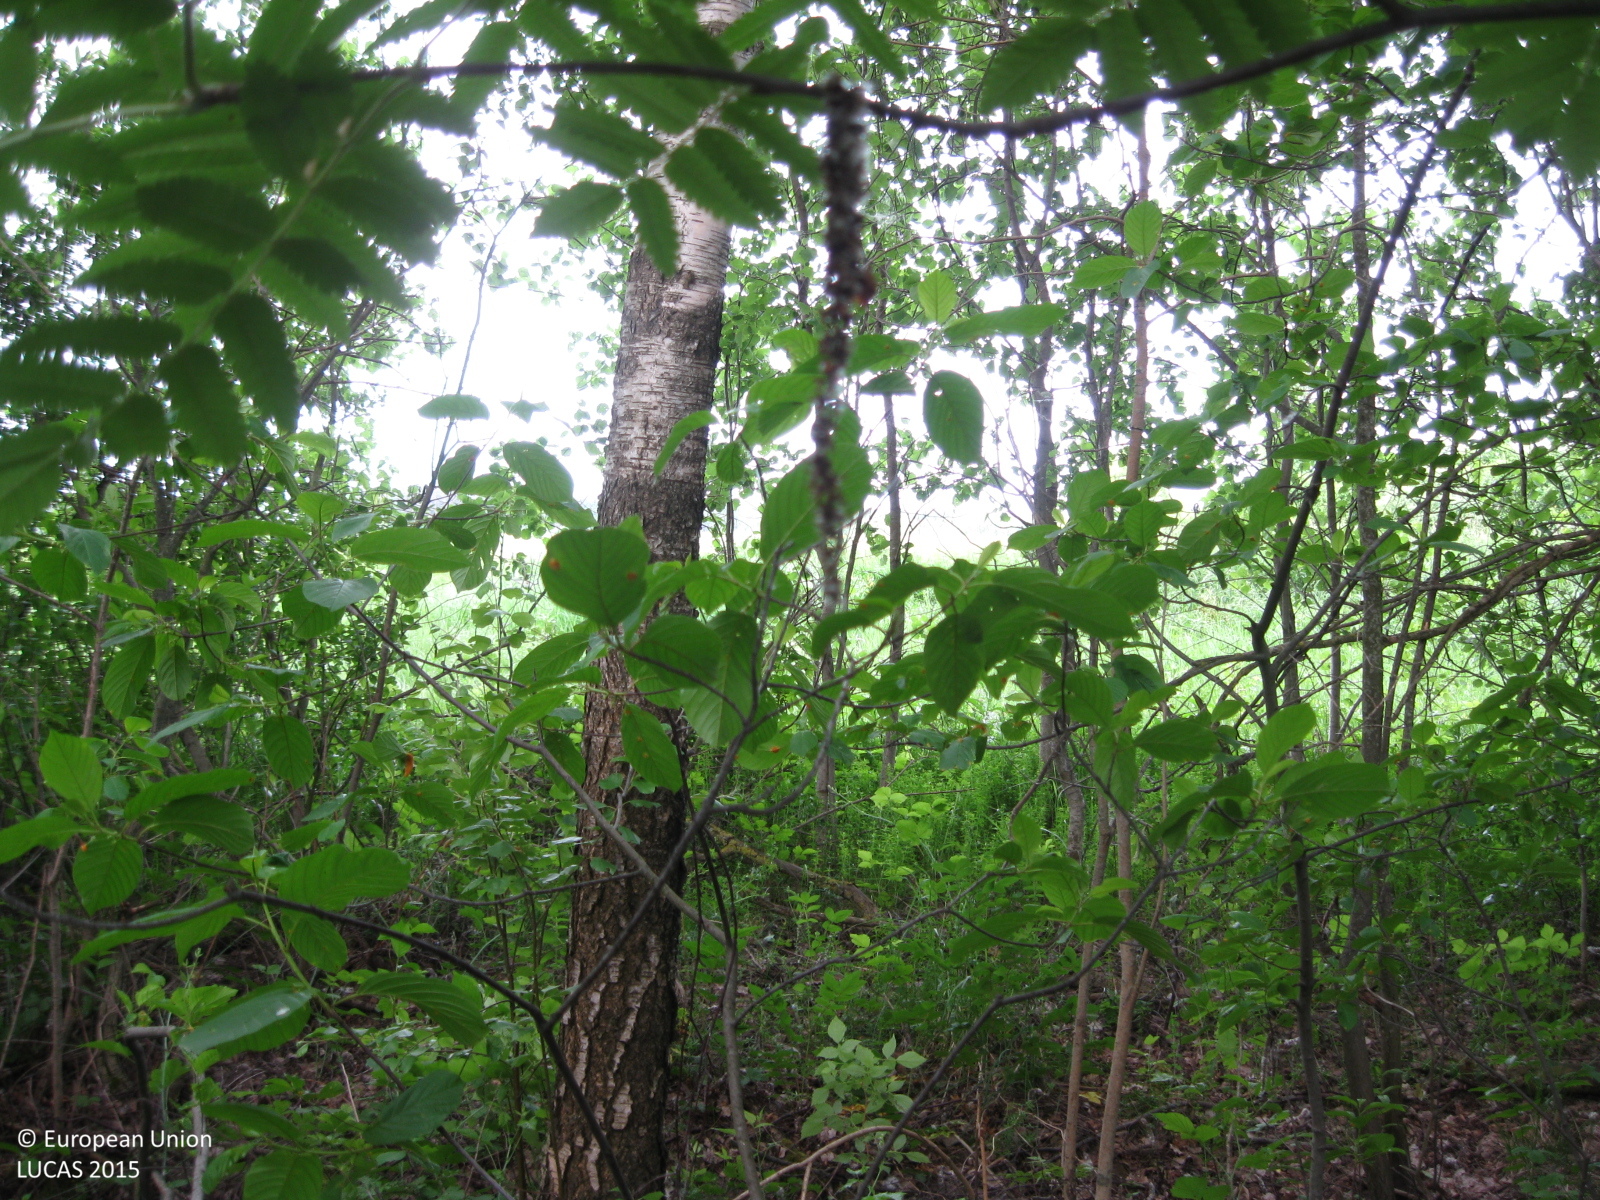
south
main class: Woodland
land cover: Broadleaved woodland
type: non-riverine alder, birch or aspen forest
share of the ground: > 75 %
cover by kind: broadleaved forest trees 75 %, shrubs 10 %, herbaceous plants 10 %, coniferous forest trees 5 %
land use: Semi-natural and natural areas not in use
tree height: > 5 m
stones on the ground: < 10 %
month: June
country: LT
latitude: 55.7262
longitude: 23.6631
